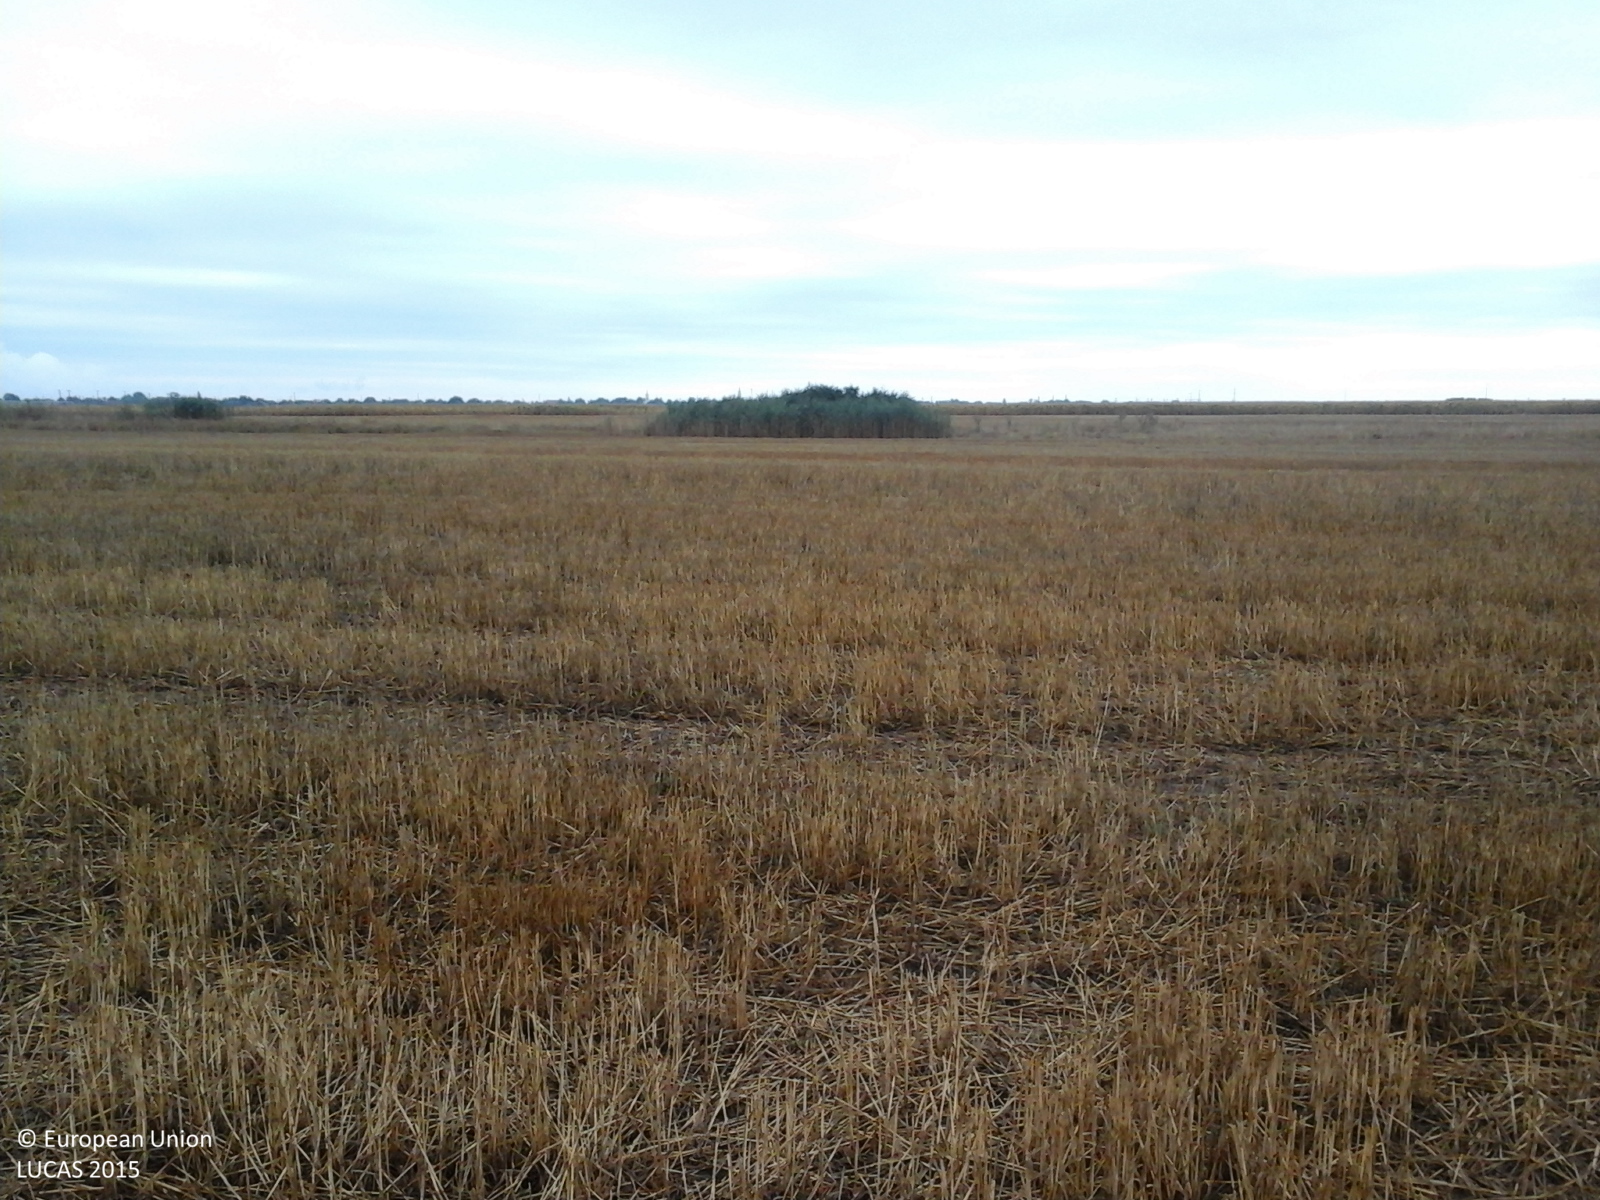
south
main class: Cropland
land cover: Common wheat
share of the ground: 50 - 75 %
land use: Agriculture (excluding fallow land and kitchen gardens)
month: August
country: RO
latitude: 45.5659
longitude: 20.9816
